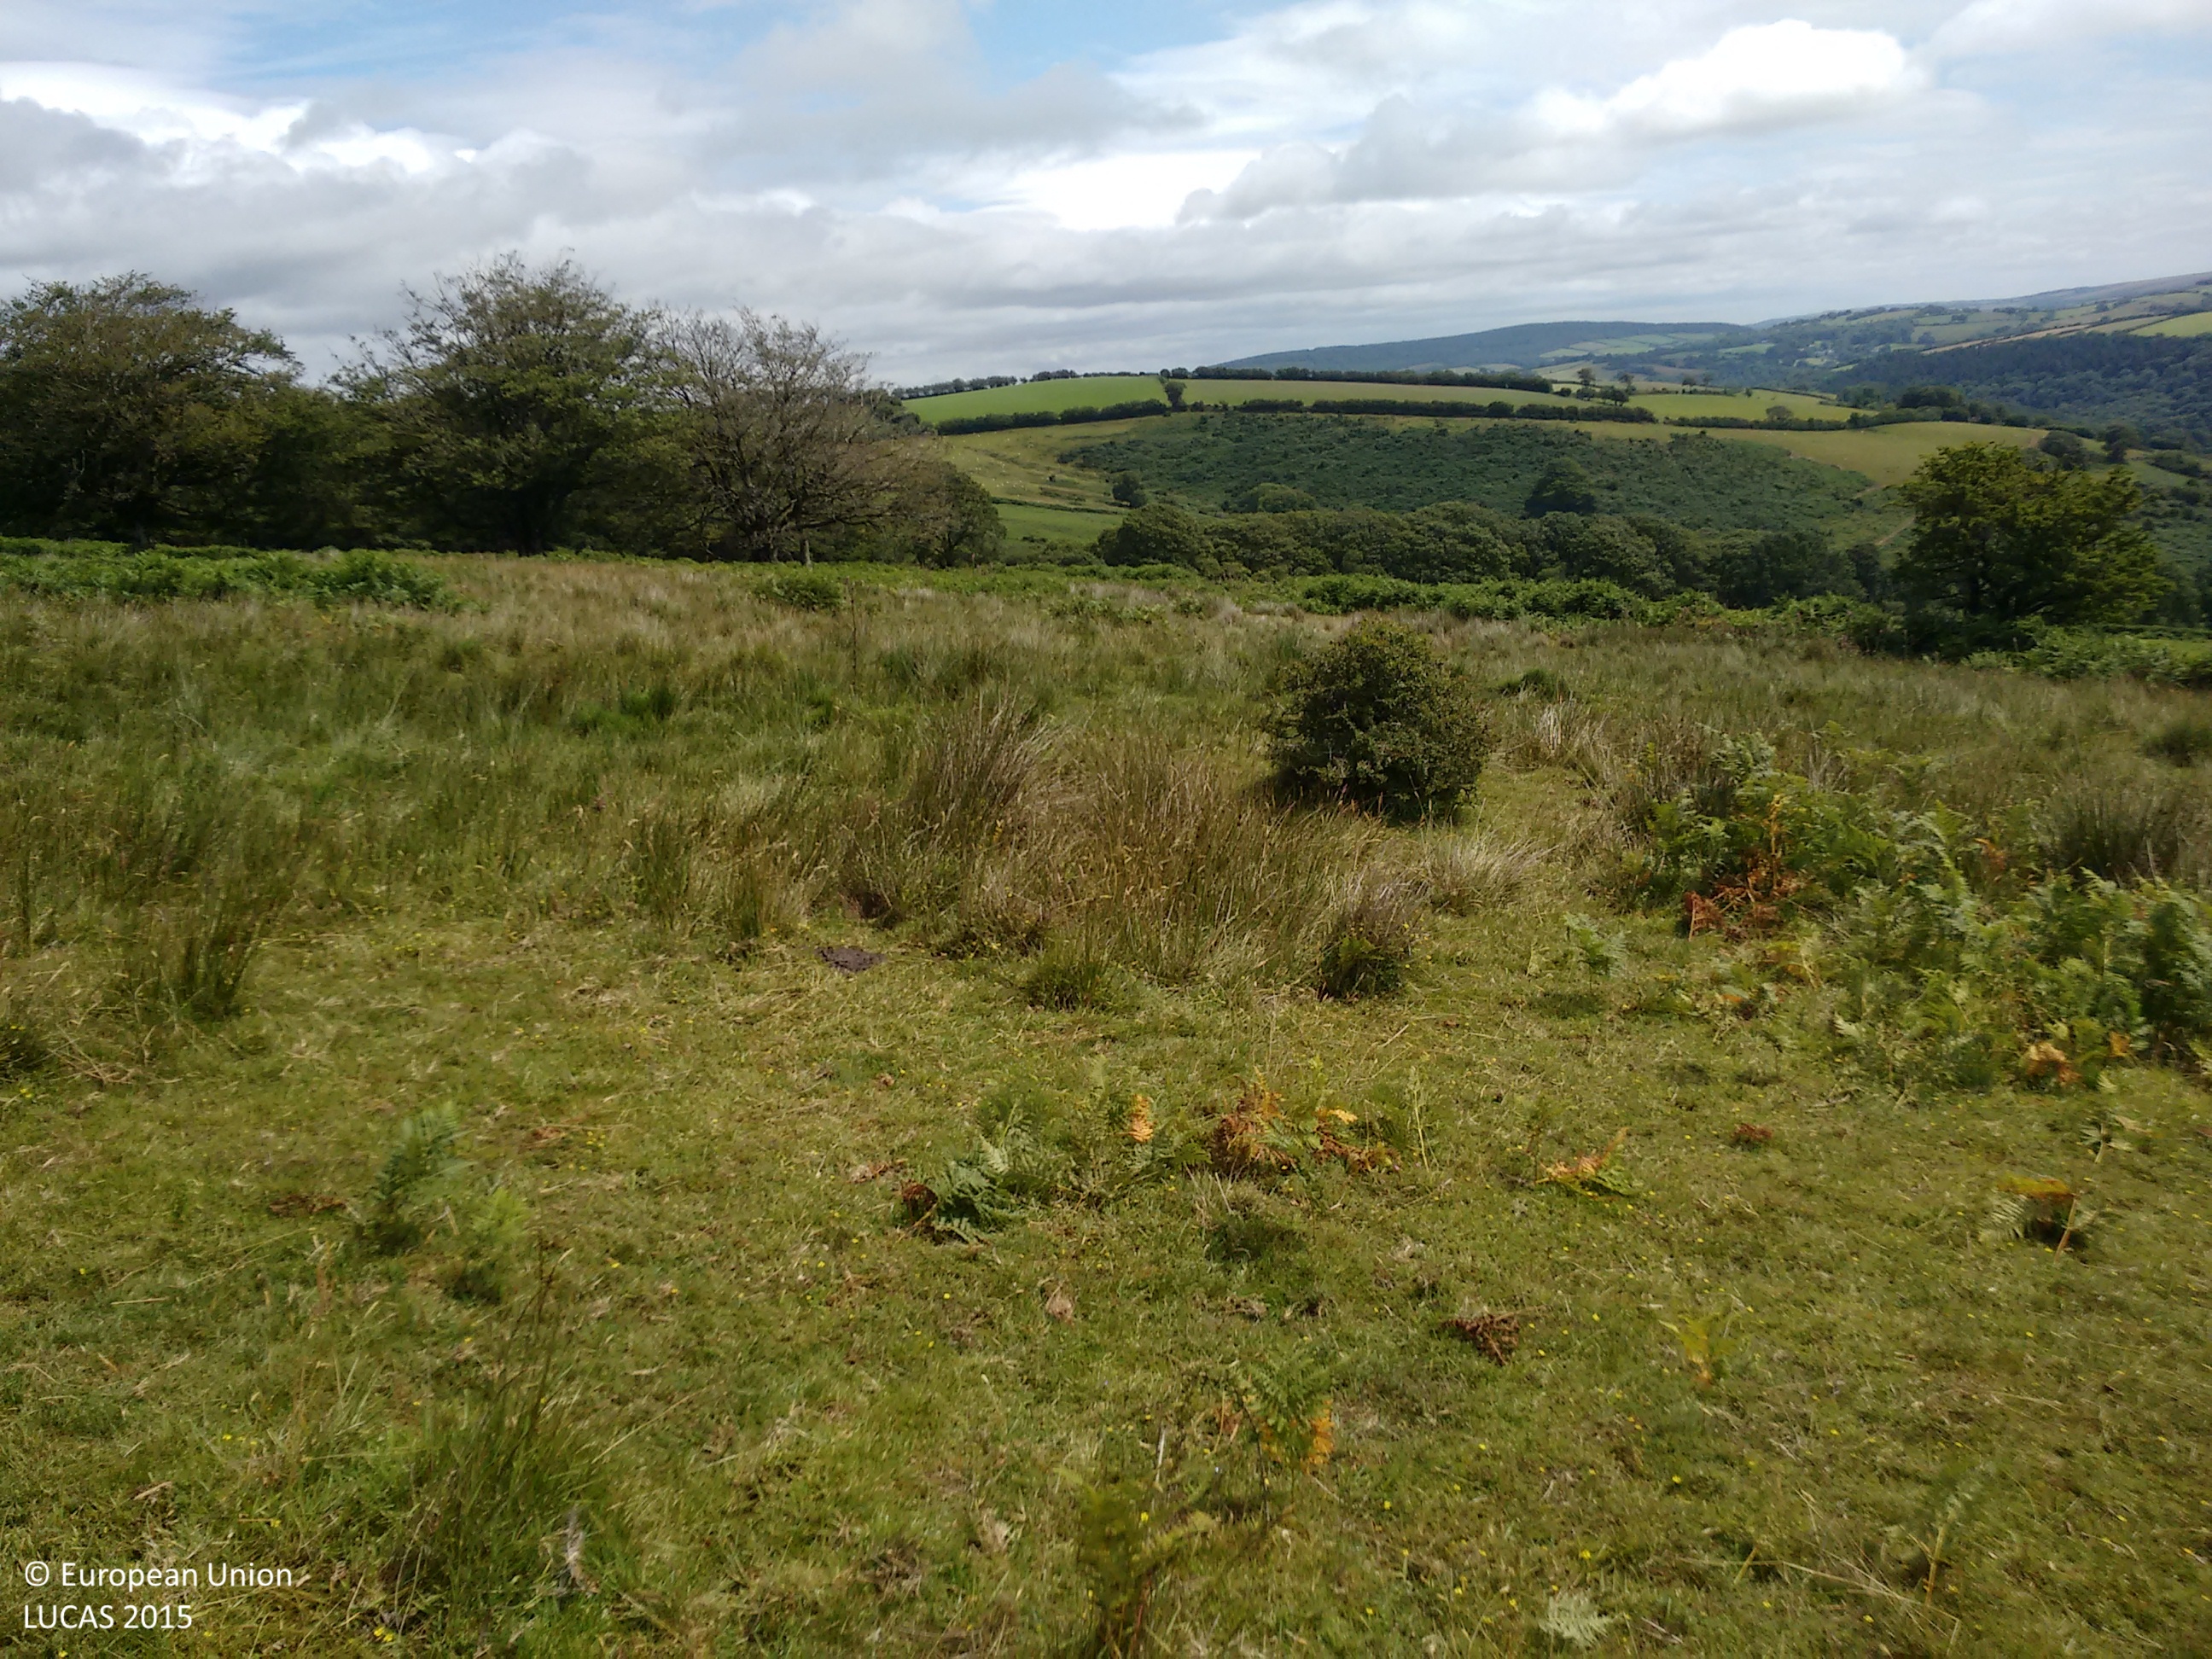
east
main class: Grassland
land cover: Grassland without tree/shrub cover
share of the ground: > 75 %
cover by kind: herbaceous plants 100 %
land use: Agriculture (excluding fallow land and kitchen gardens)
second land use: Amenities, museums, leisure
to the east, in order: Grassland without tree/shrub cover; Inland marshes; Grassland without tree/shrub cover; Inland marshes; Rivers and streams; Grassland without tree/shrub cover; Inland marshes; Grassland without tree/shrub cover
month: July
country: GB
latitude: 51.1558
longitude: -3.5684
